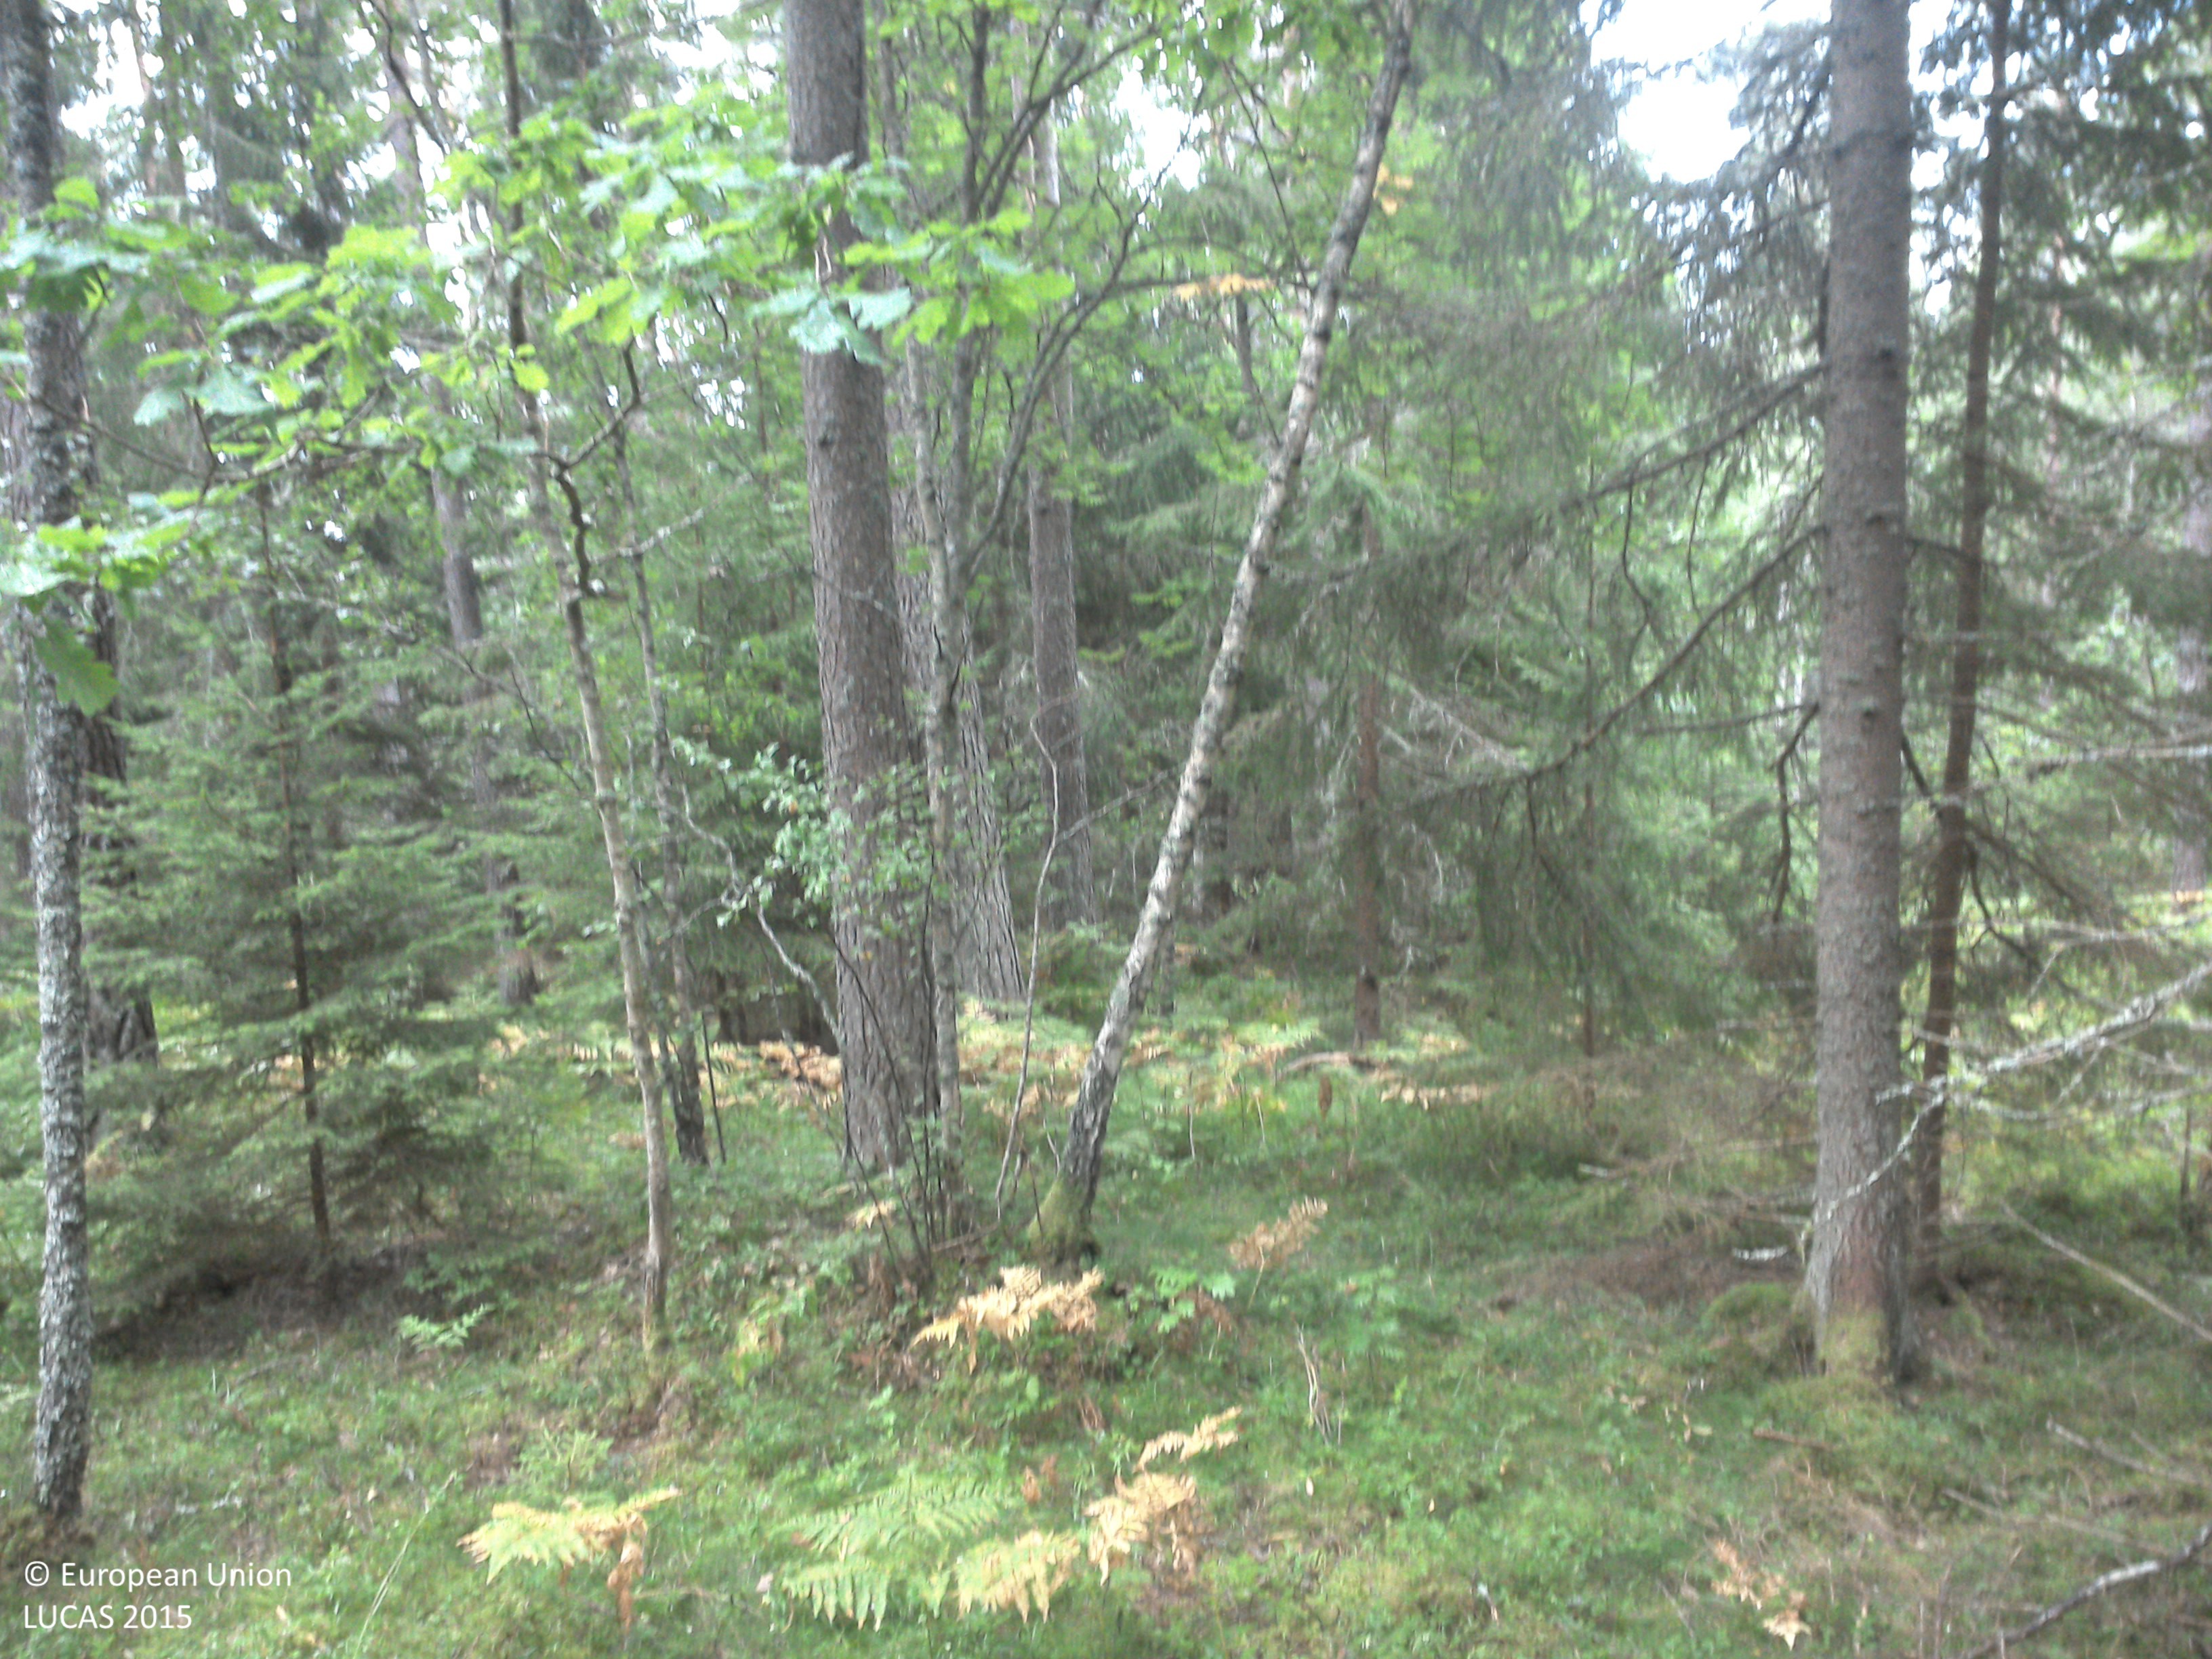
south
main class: Woodland
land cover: Pine dominated coniferous woodland
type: boreal forest
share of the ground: 25 - 50 %
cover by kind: coniferous forest trees 45 %, lichens and mosses 45 %, herbaceous plants 10 %
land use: Forestry
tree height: > 5 m
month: August
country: SE
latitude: 57.8113
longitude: 15.2300
